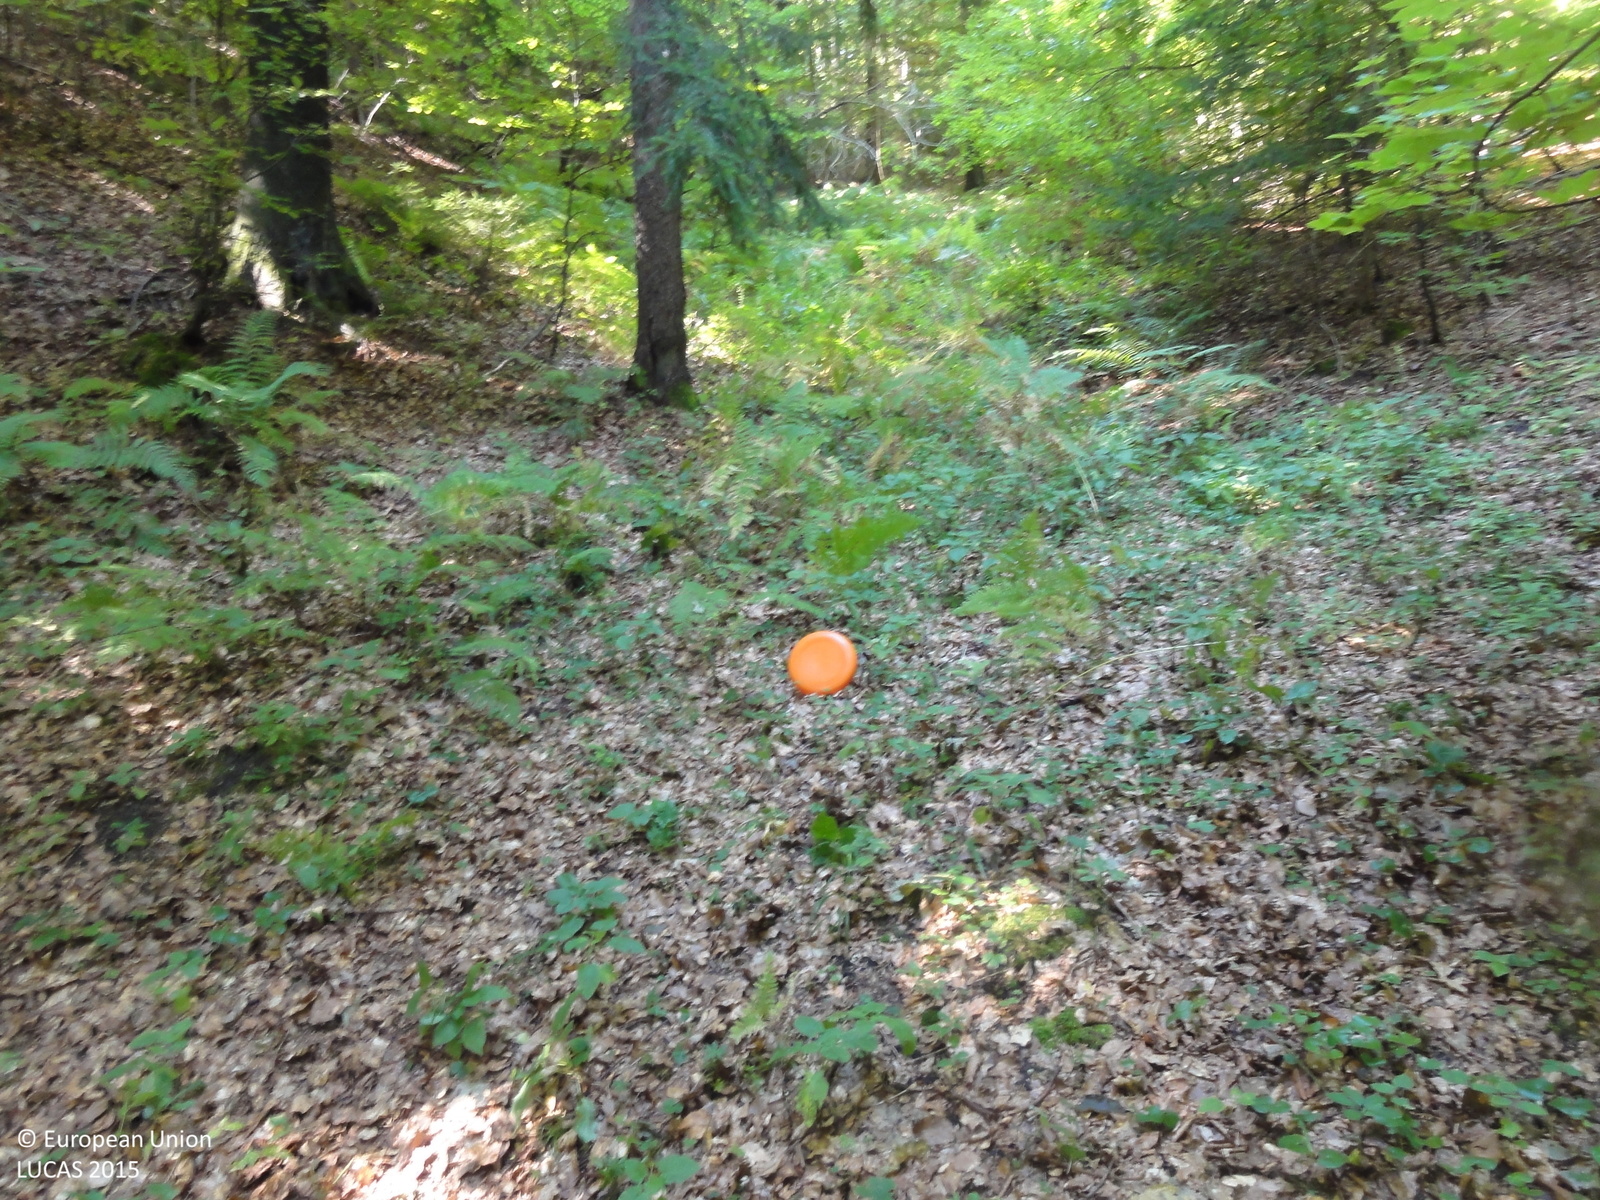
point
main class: Woodland
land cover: Spruce dominated mixed woodland
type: mountainous beech forest
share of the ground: > 75 %
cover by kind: broadleaved forest trees 60 %, coniferous forest trees 25 %, herbaceous plants 10 %, shrubs 5 %
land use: Forestry
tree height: > 5 m
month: August
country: SI
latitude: 46.1556
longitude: 15.1380
